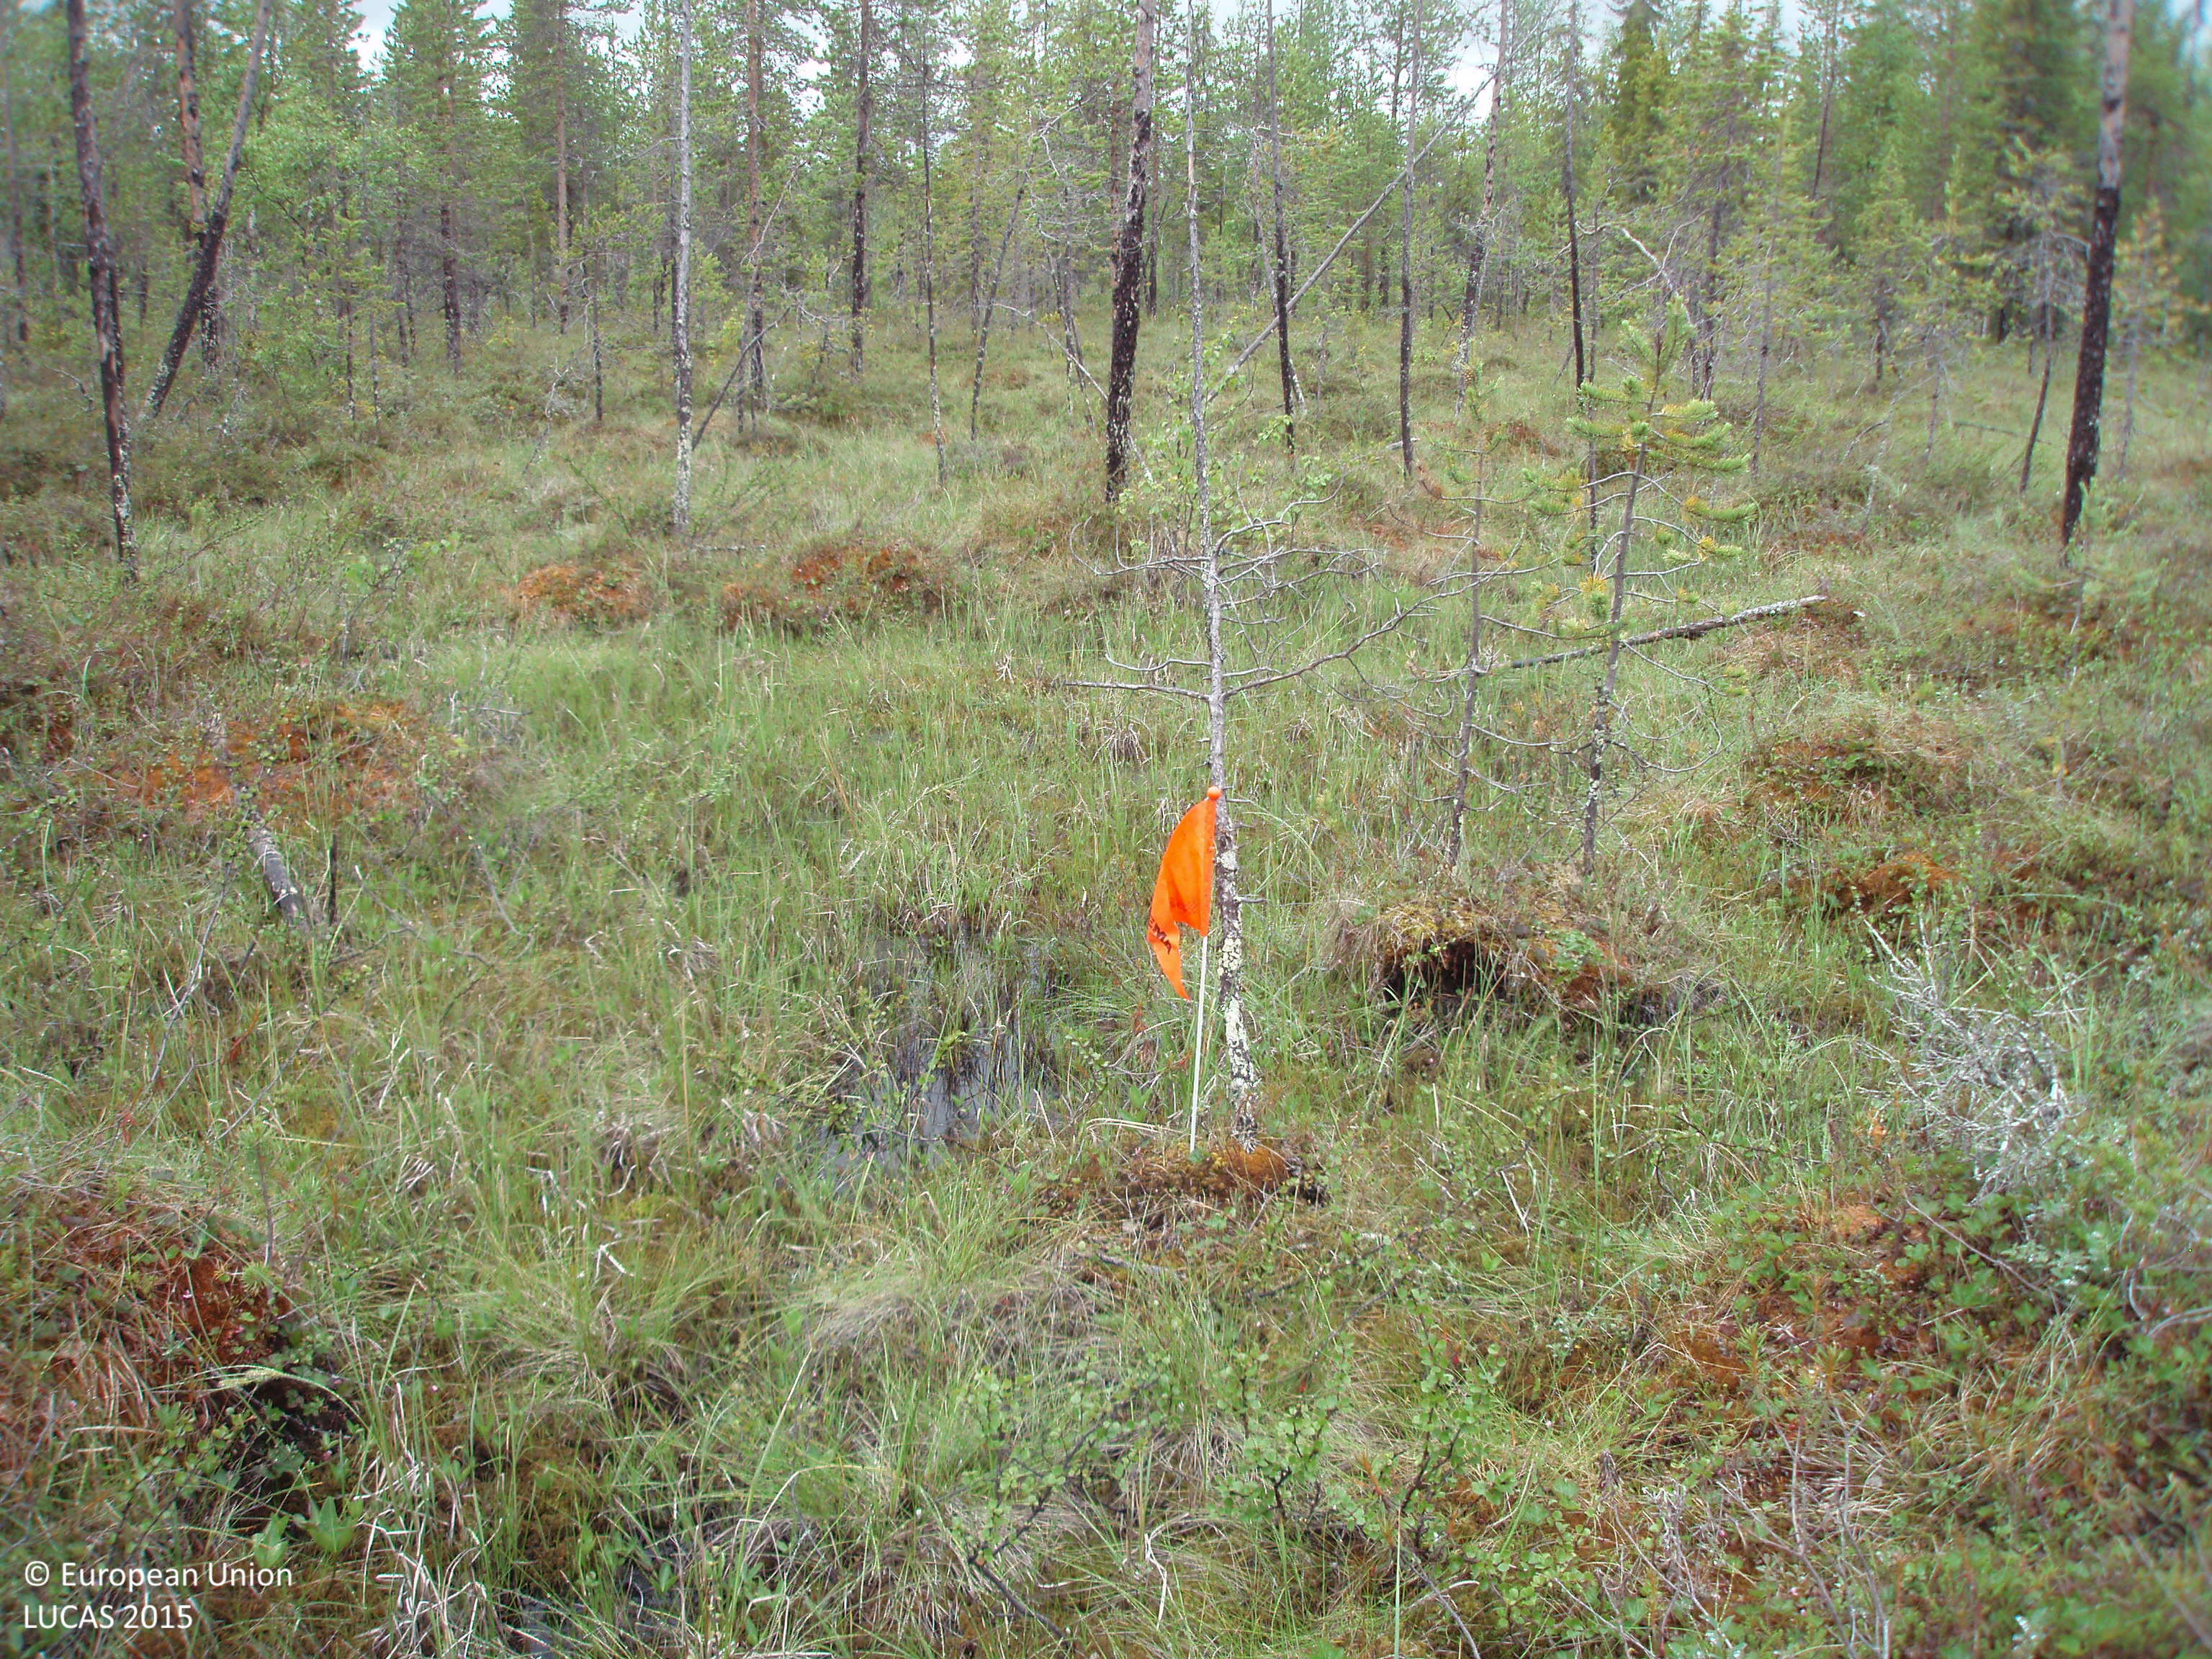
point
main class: Woodland
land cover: Pine dominated coniferous woodland
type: mire and swamp forests
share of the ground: 25 - 50 %
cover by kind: shrubs 70 %, coniferous forest trees 30 %
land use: Semi-natural and natural areas not in use
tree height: > 5 m
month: July
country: FI
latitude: 67.1717
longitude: 28.6403
